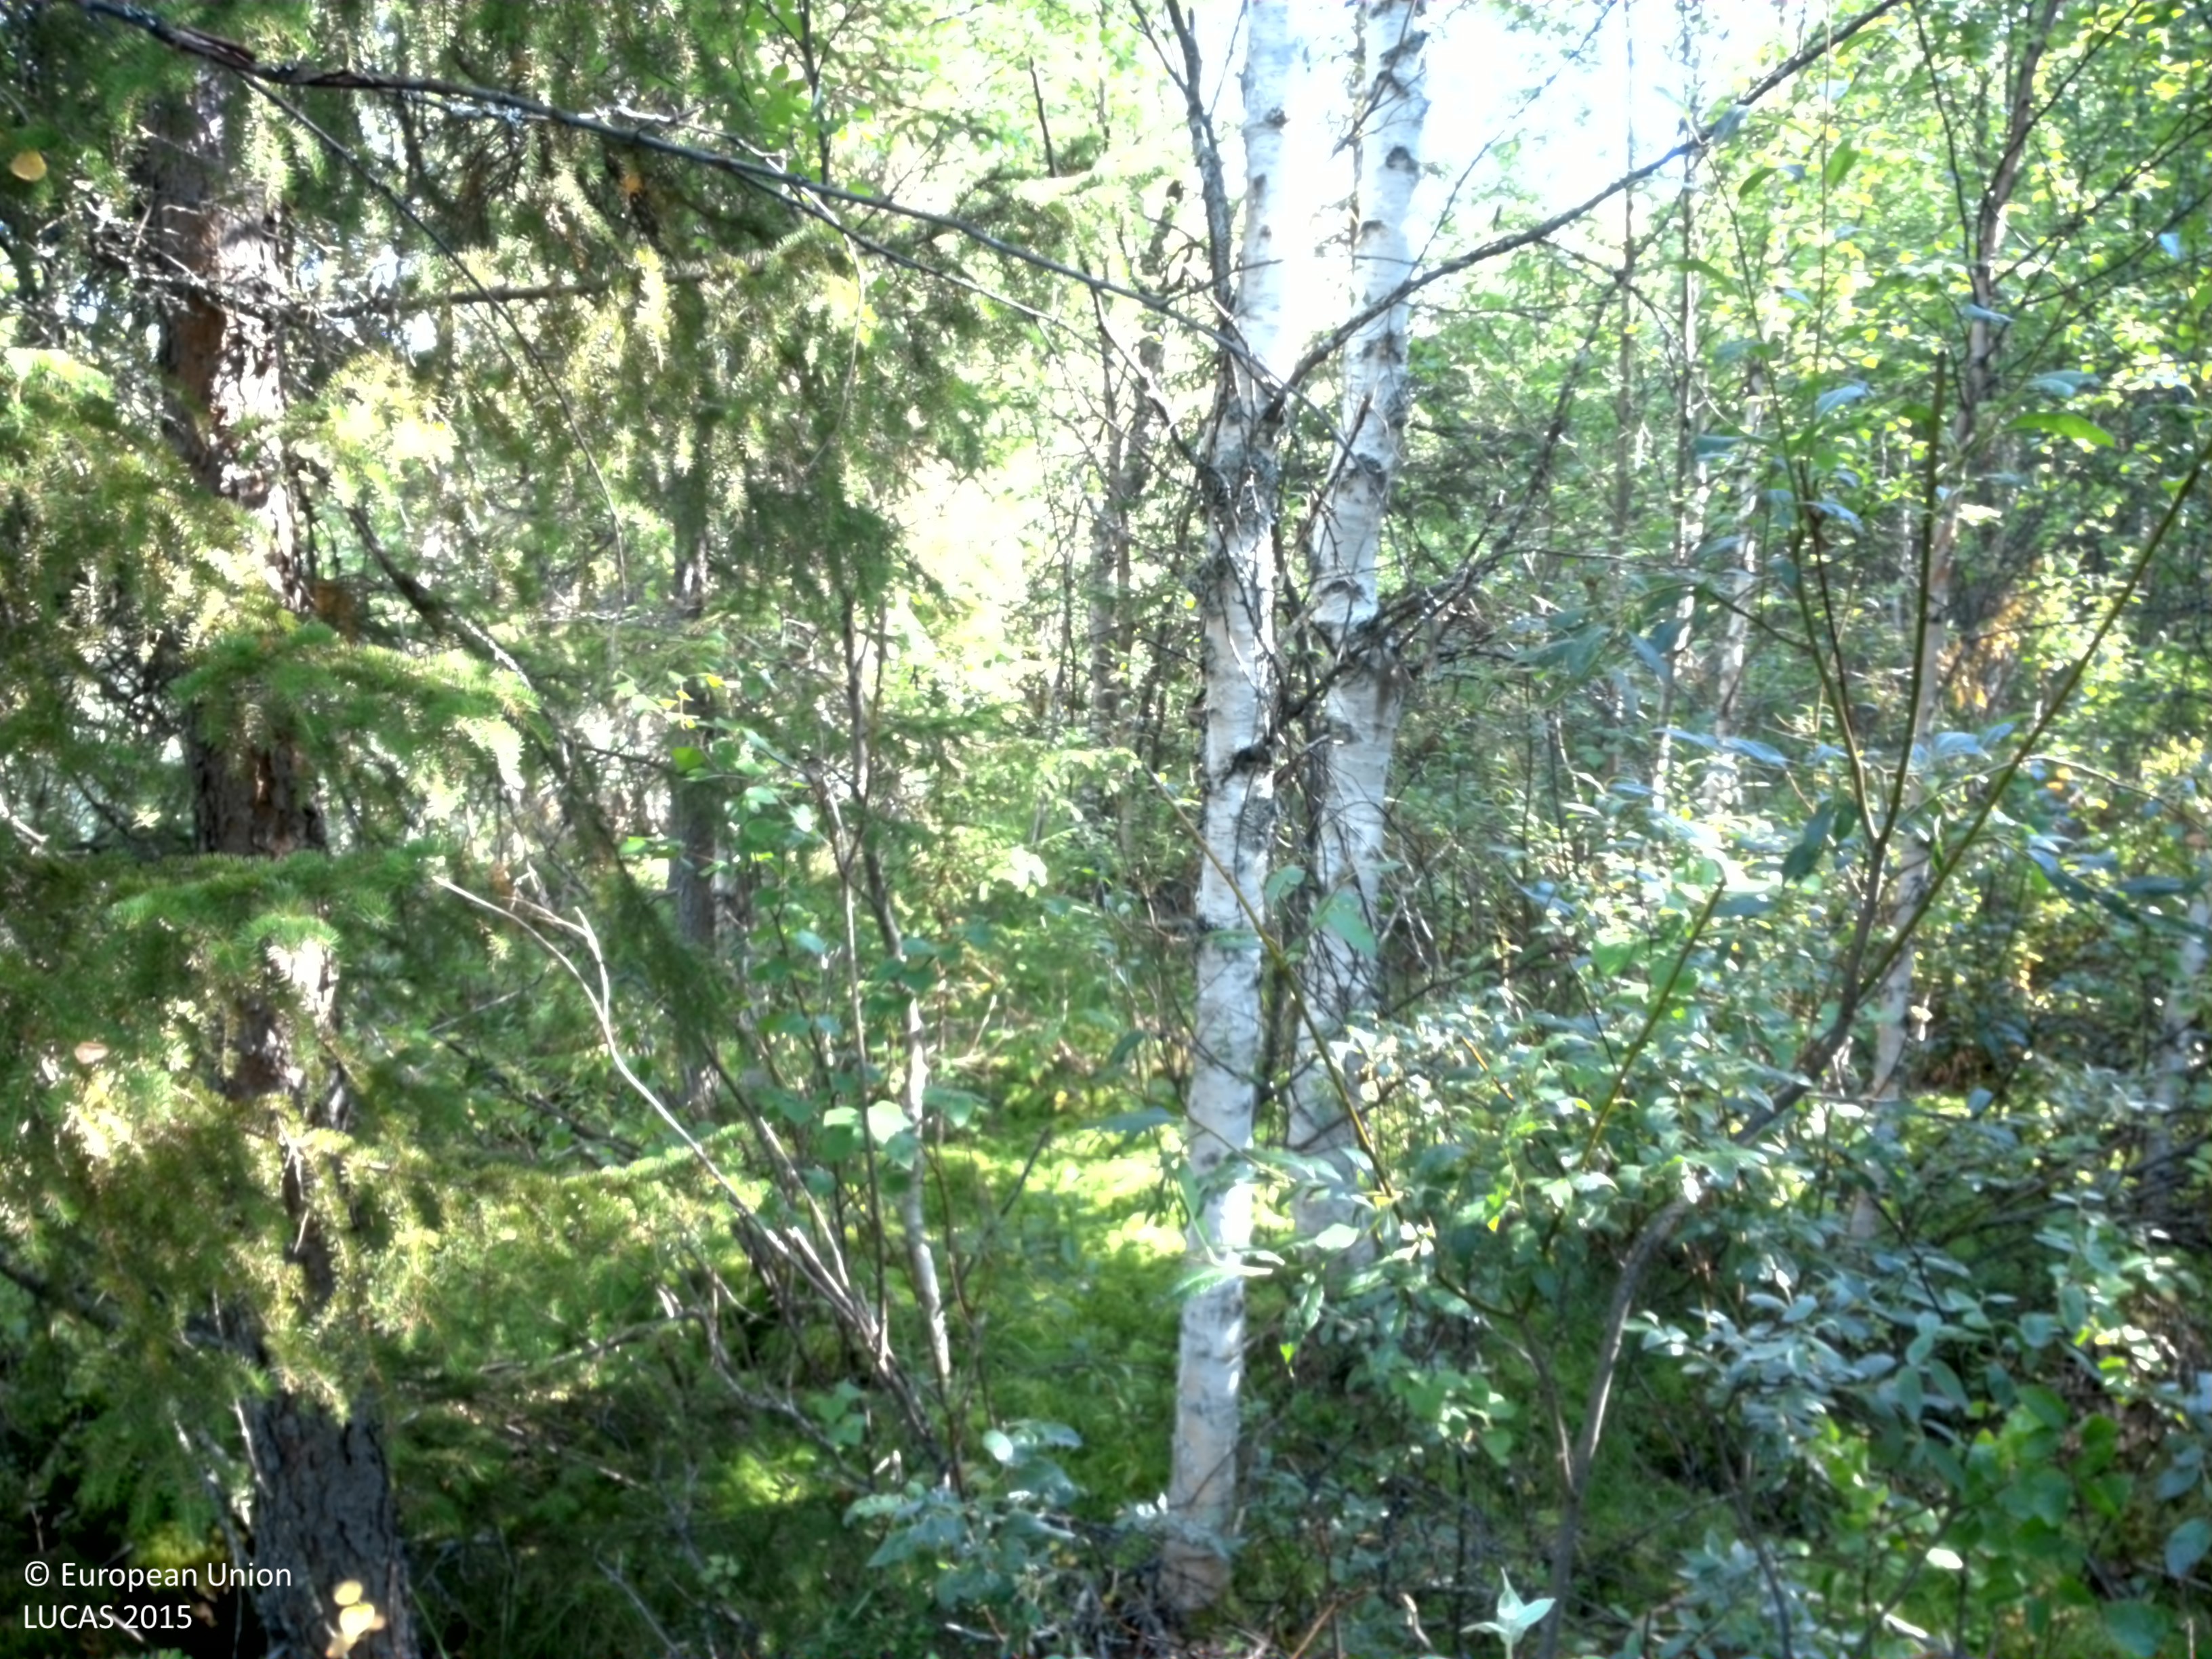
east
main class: Woodland
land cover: Broadleaved woodland
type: non-riverine alder, birch or aspen forest
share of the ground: 25 - 50 %
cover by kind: shrubs 40 %, broadleaved forest trees 35 %, coniferous forest trees 10 %, lichens and mosses 10 %, herbaceous plants 5 %
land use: Semi-natural and natural areas not in use
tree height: > 5 m
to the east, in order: Broadleaved woodland; Shrubland with sparse tree cover; Rivers and streams; Broadleaved woodland; Ditches and canals; Broadleaved woodland; Other bare soil; Grassland with sparse tree/shrub cover; Paved roads, cycling and walking lanes; Grassland with sparse tree/shrub cover; Broadleaved woodland; Grassland with sparse tree/shrub cover; Broadleaved woodland
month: August
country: SE
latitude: 64.6578
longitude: 16.6463
